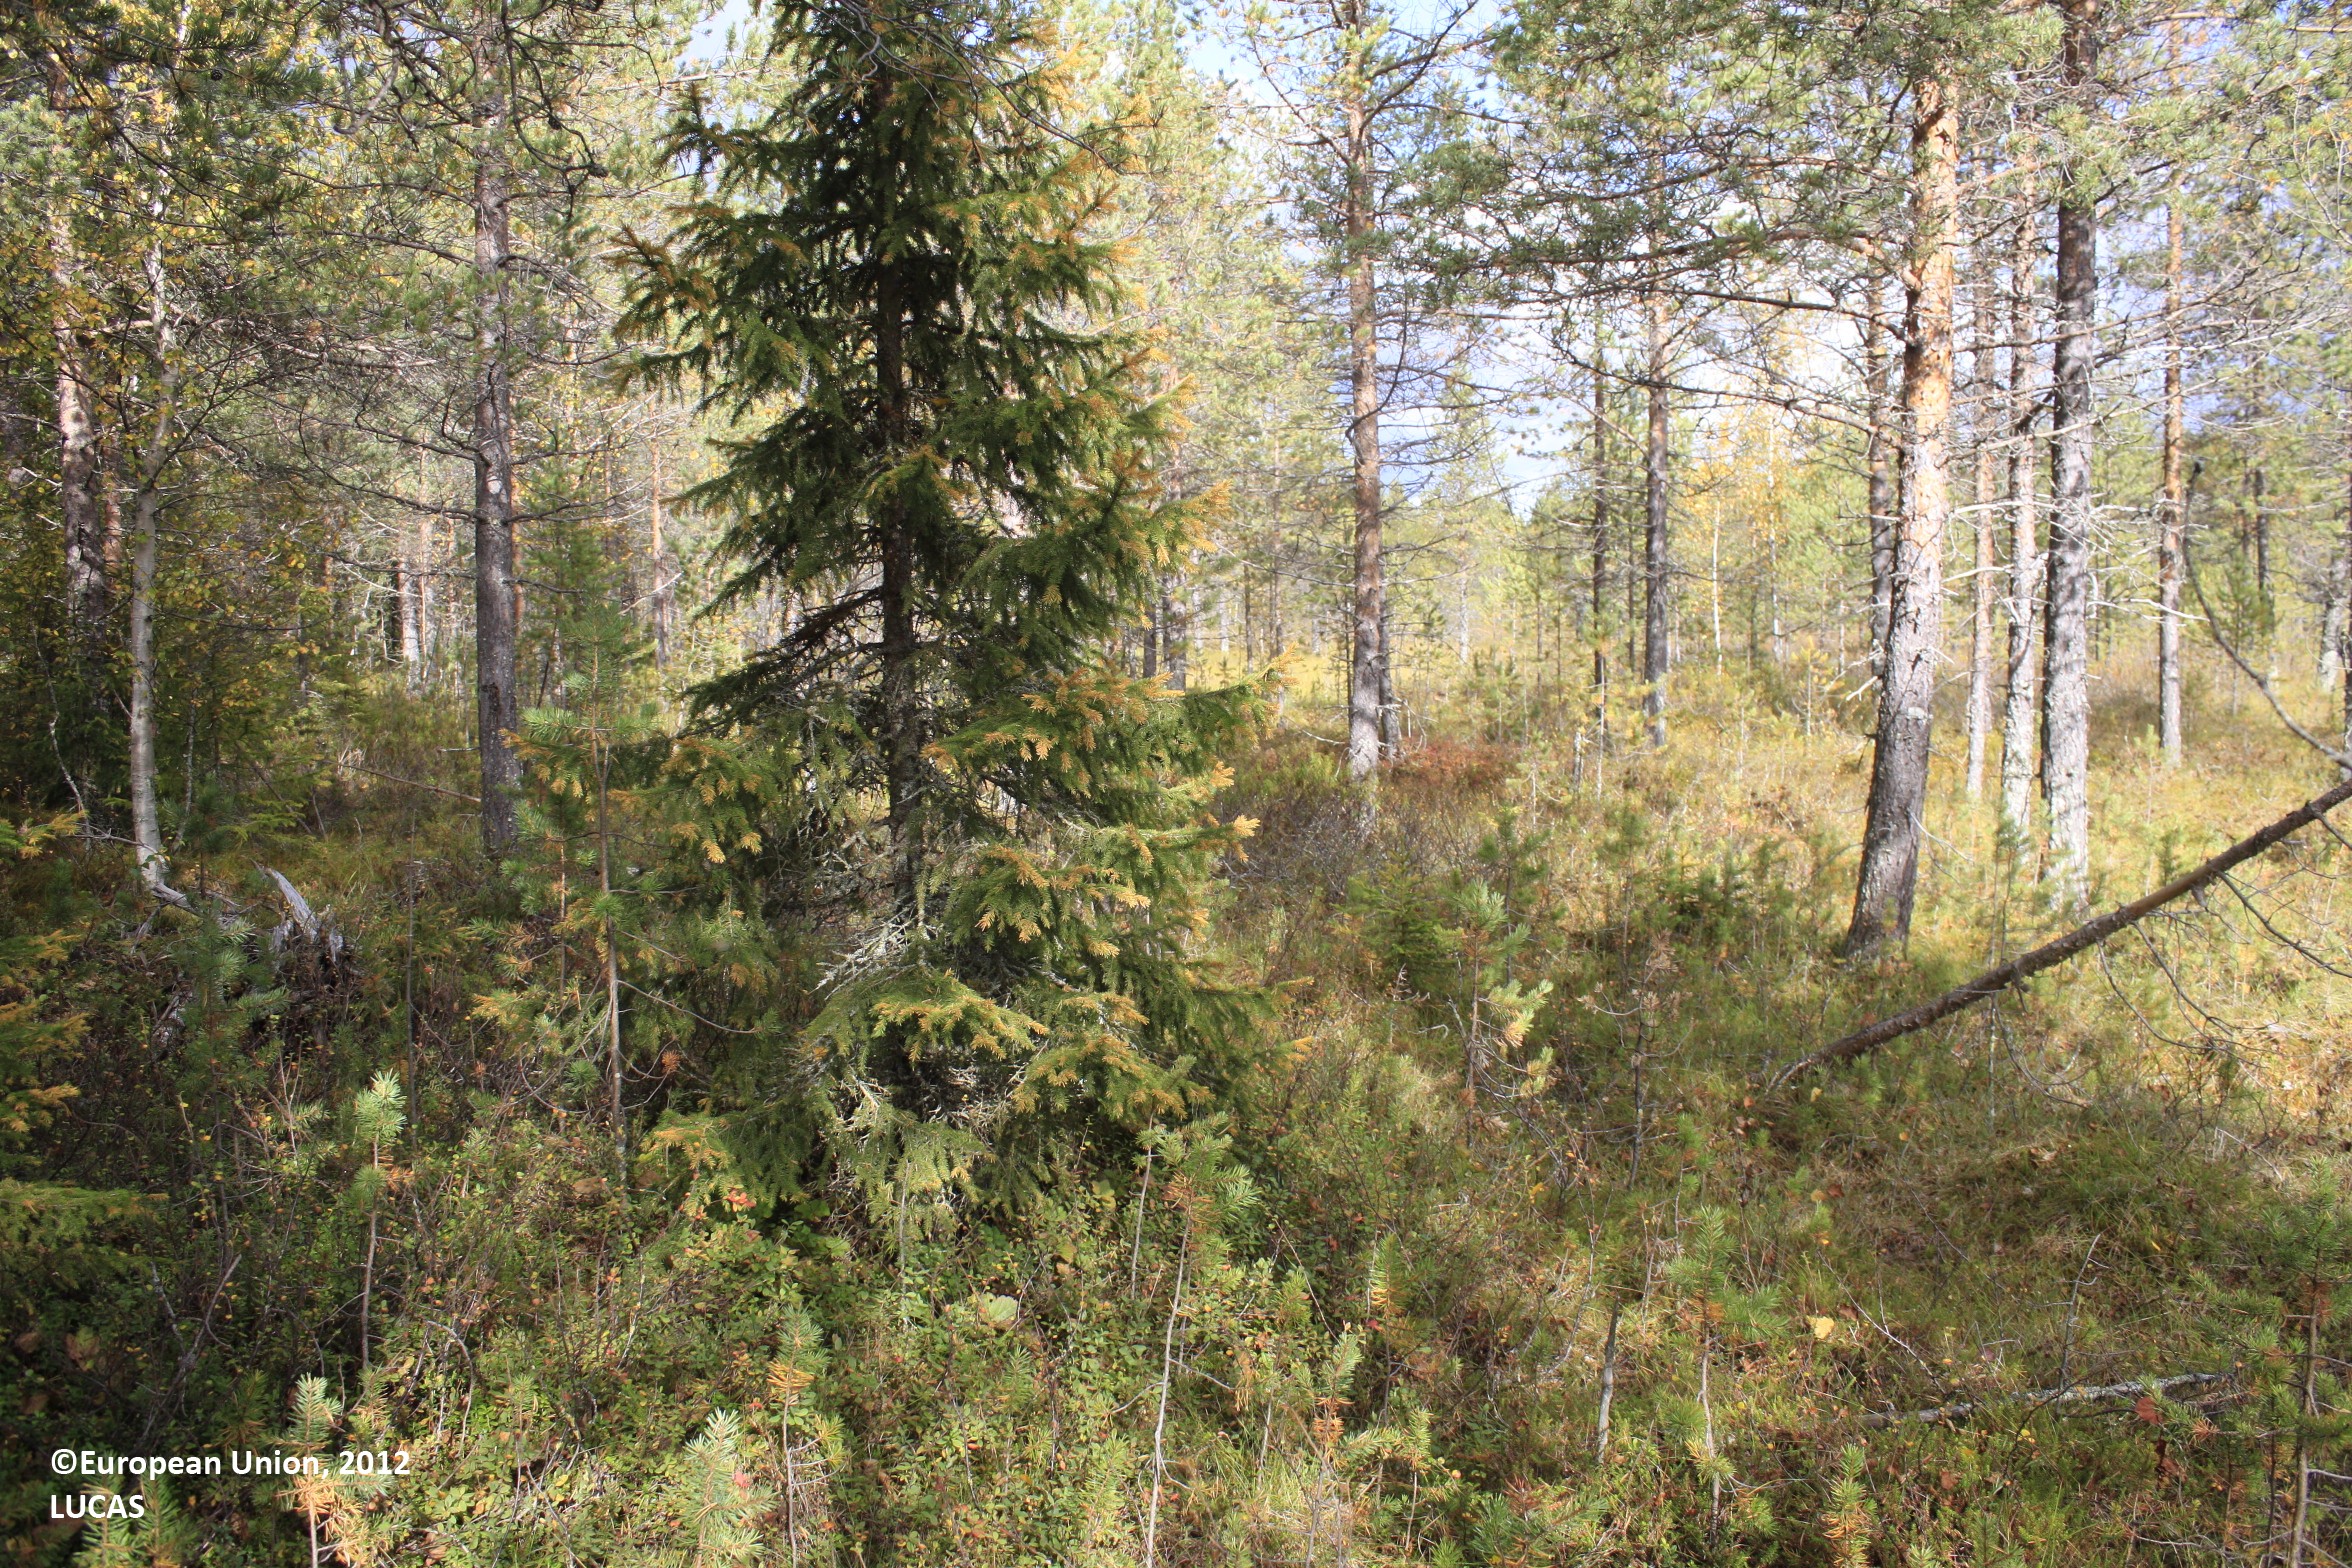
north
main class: Woodland
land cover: Pine dominated mixed woodland
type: mire and swamp forests
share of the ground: 25 - 50 %
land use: Forestry
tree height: > 5 m
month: September
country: FI
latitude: 65.6713
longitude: 26.5684
